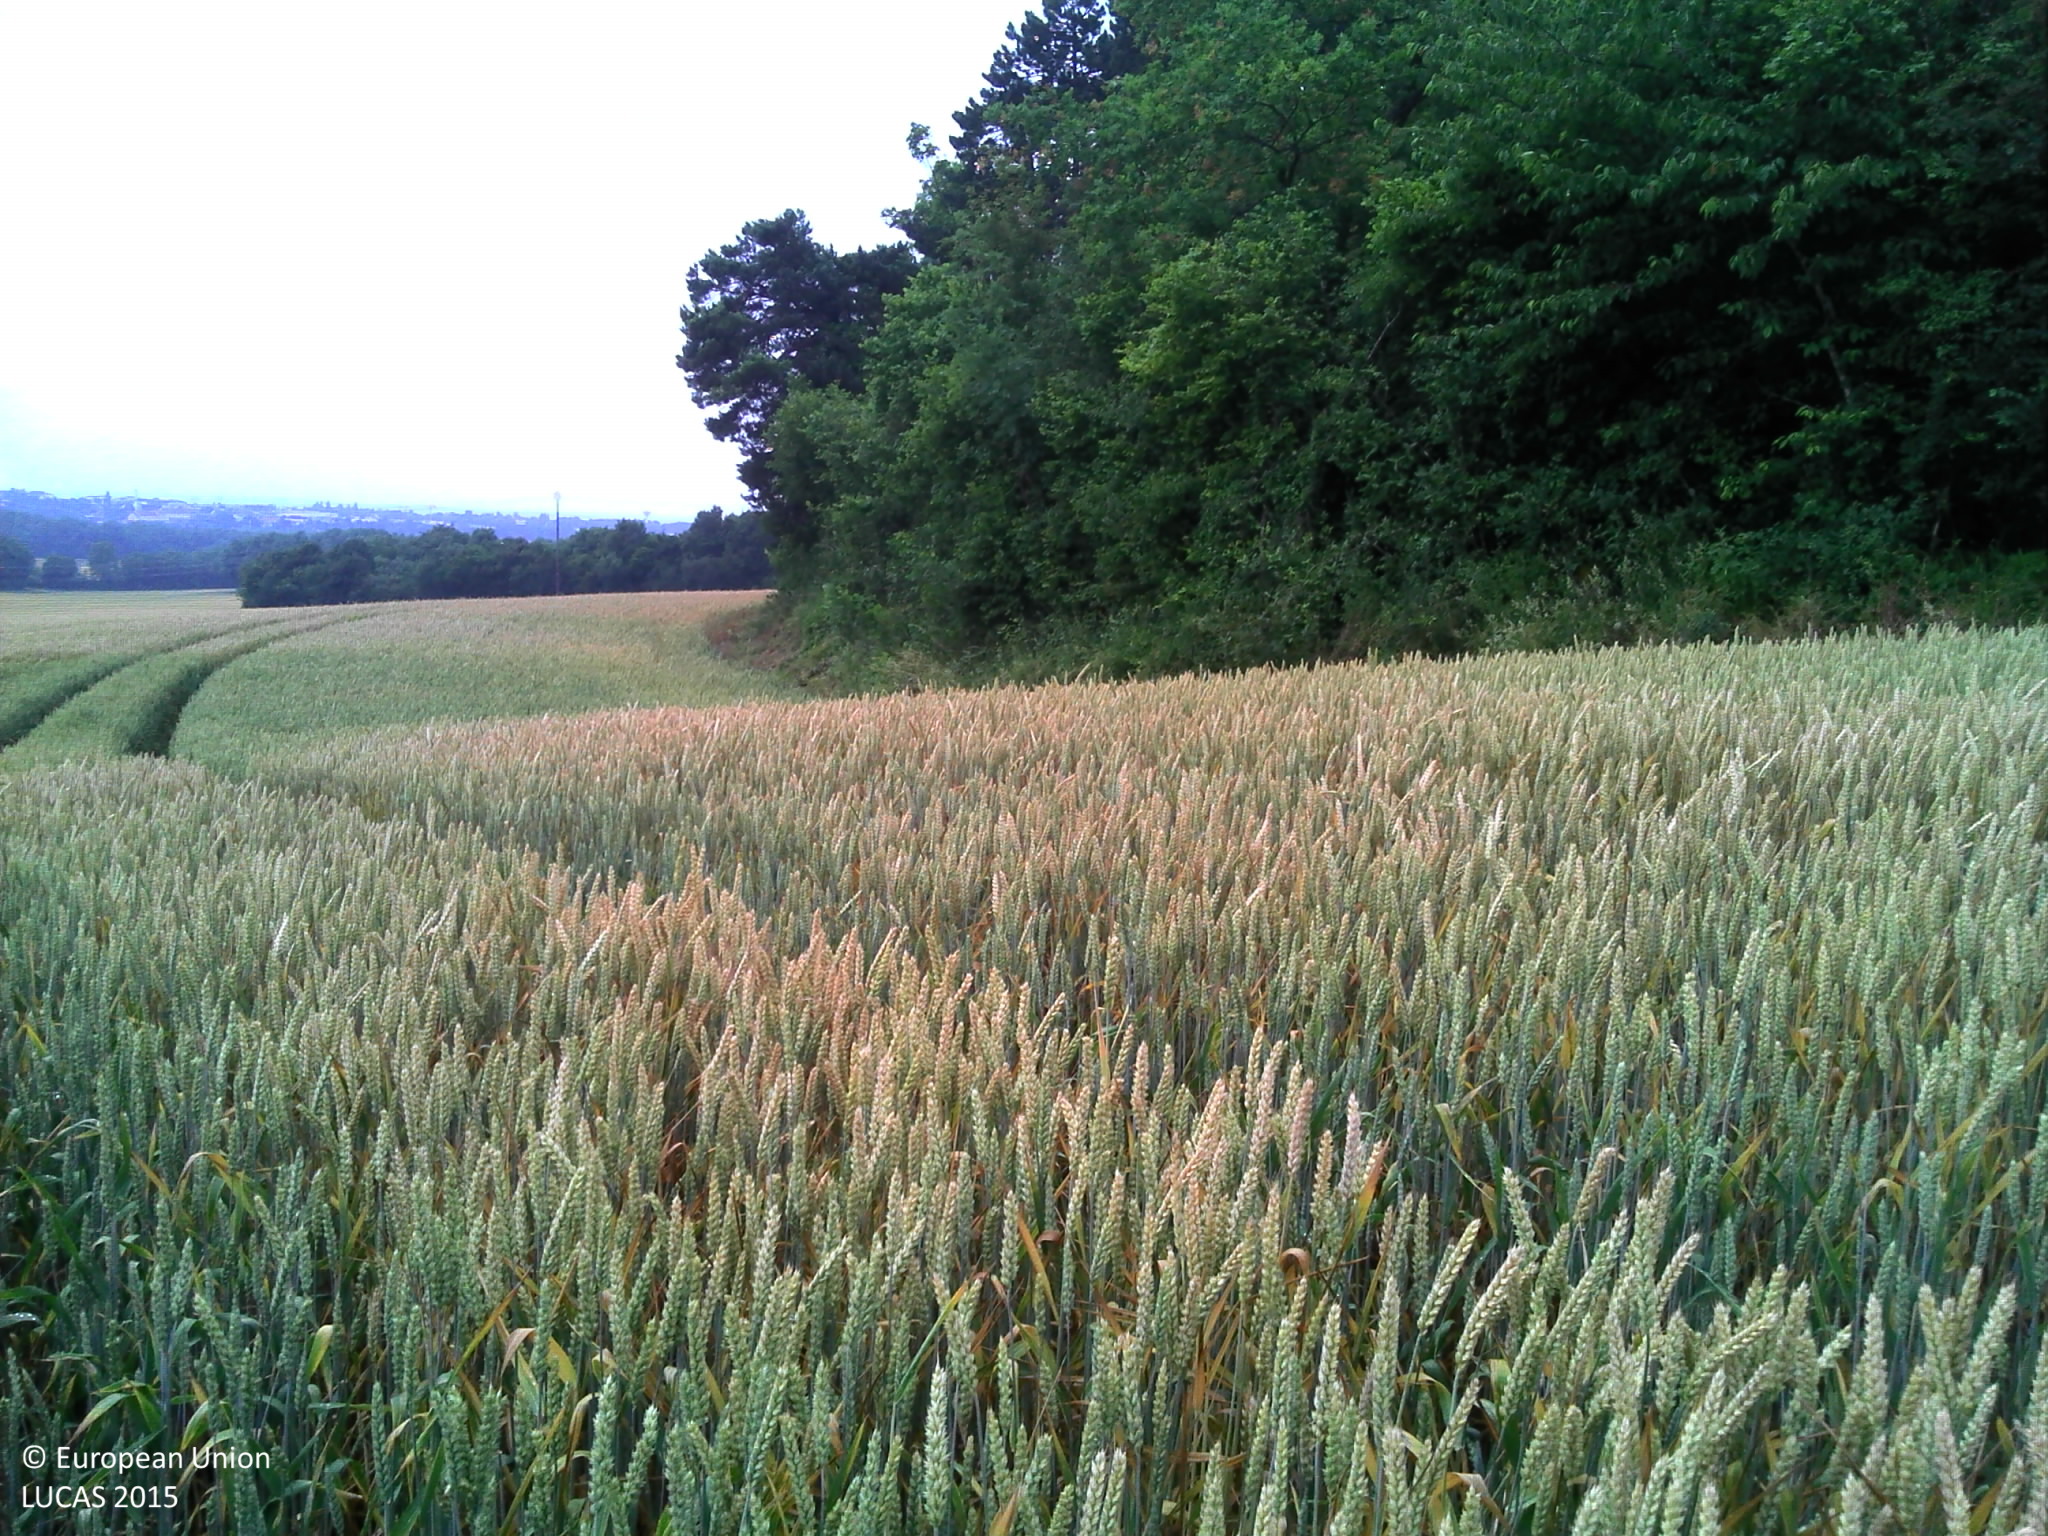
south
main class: Cropland
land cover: Common wheat
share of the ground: > 75 %
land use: Agriculture (excluding fallow land and kitchen gardens)
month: June
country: FR
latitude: 47.1023
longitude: 5.4557
